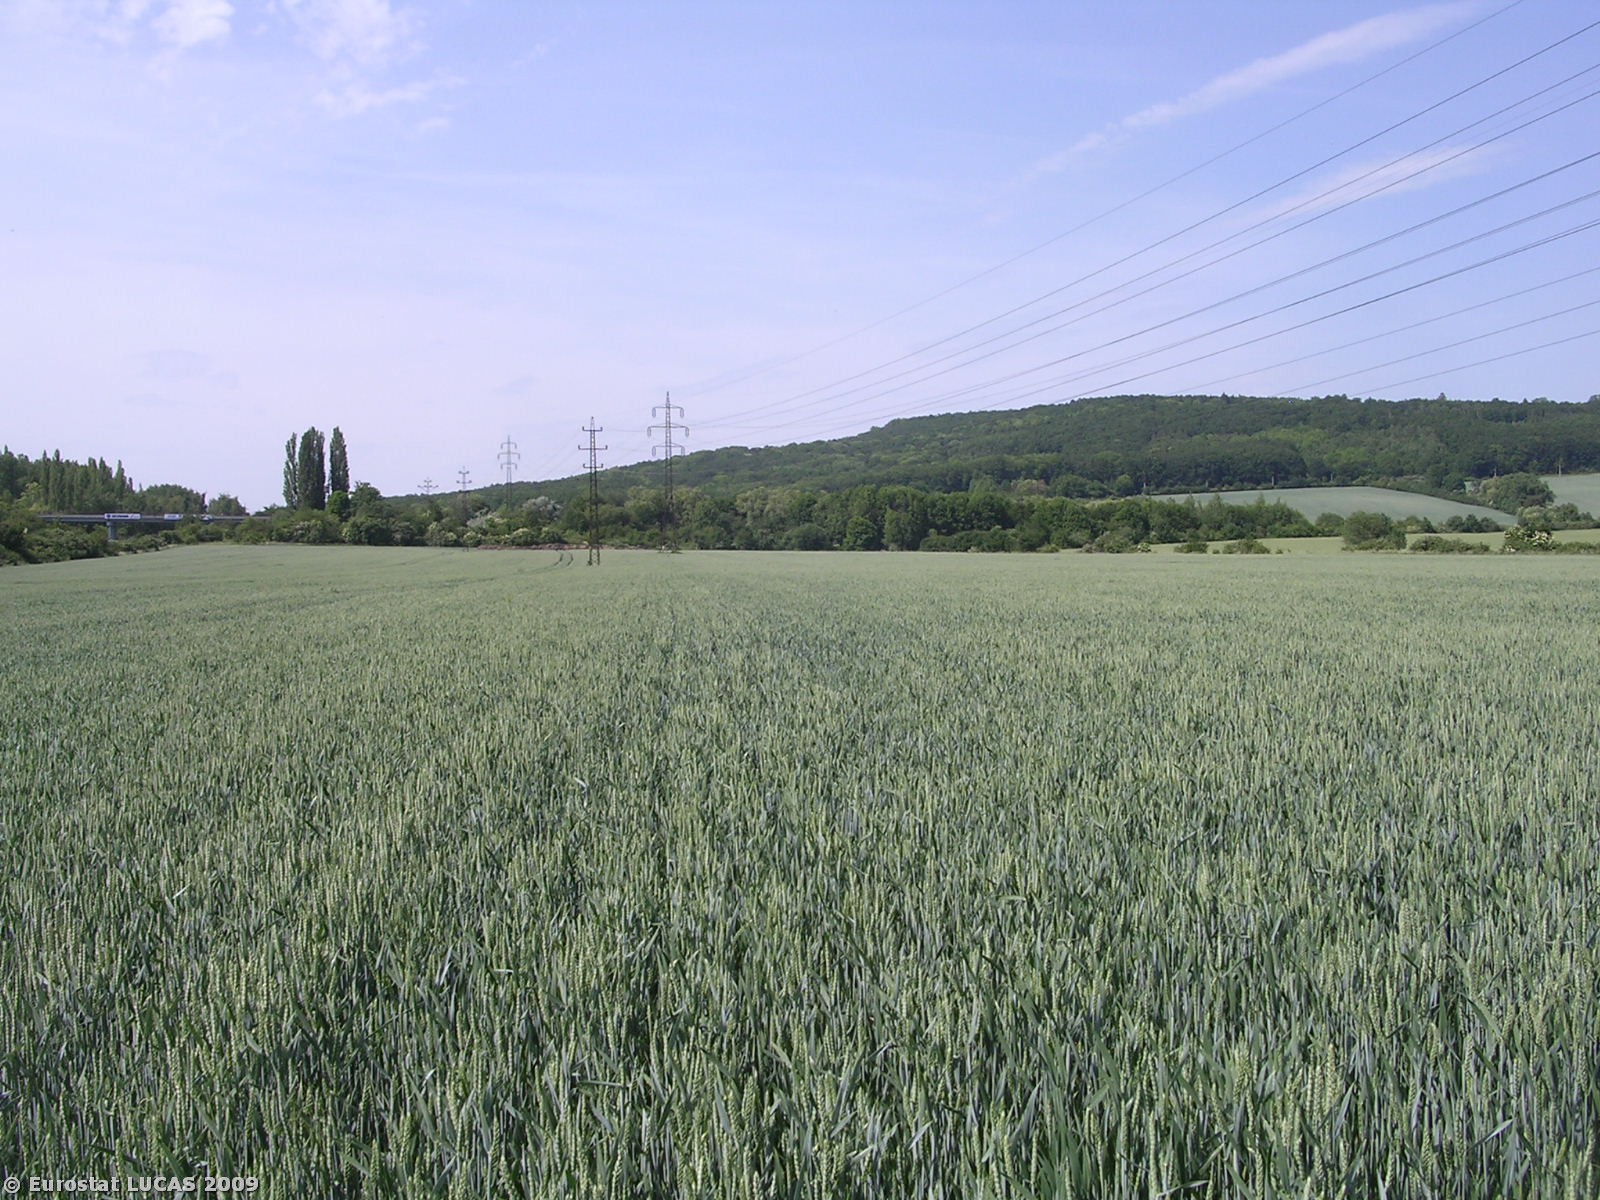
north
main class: Cropland
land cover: Common wheat
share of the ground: > 75 %
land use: Agriculture (excluding fallow land and kitchen gardens)
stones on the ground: < 10 %
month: May
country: CZ
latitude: 50.4373
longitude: 14.9447
